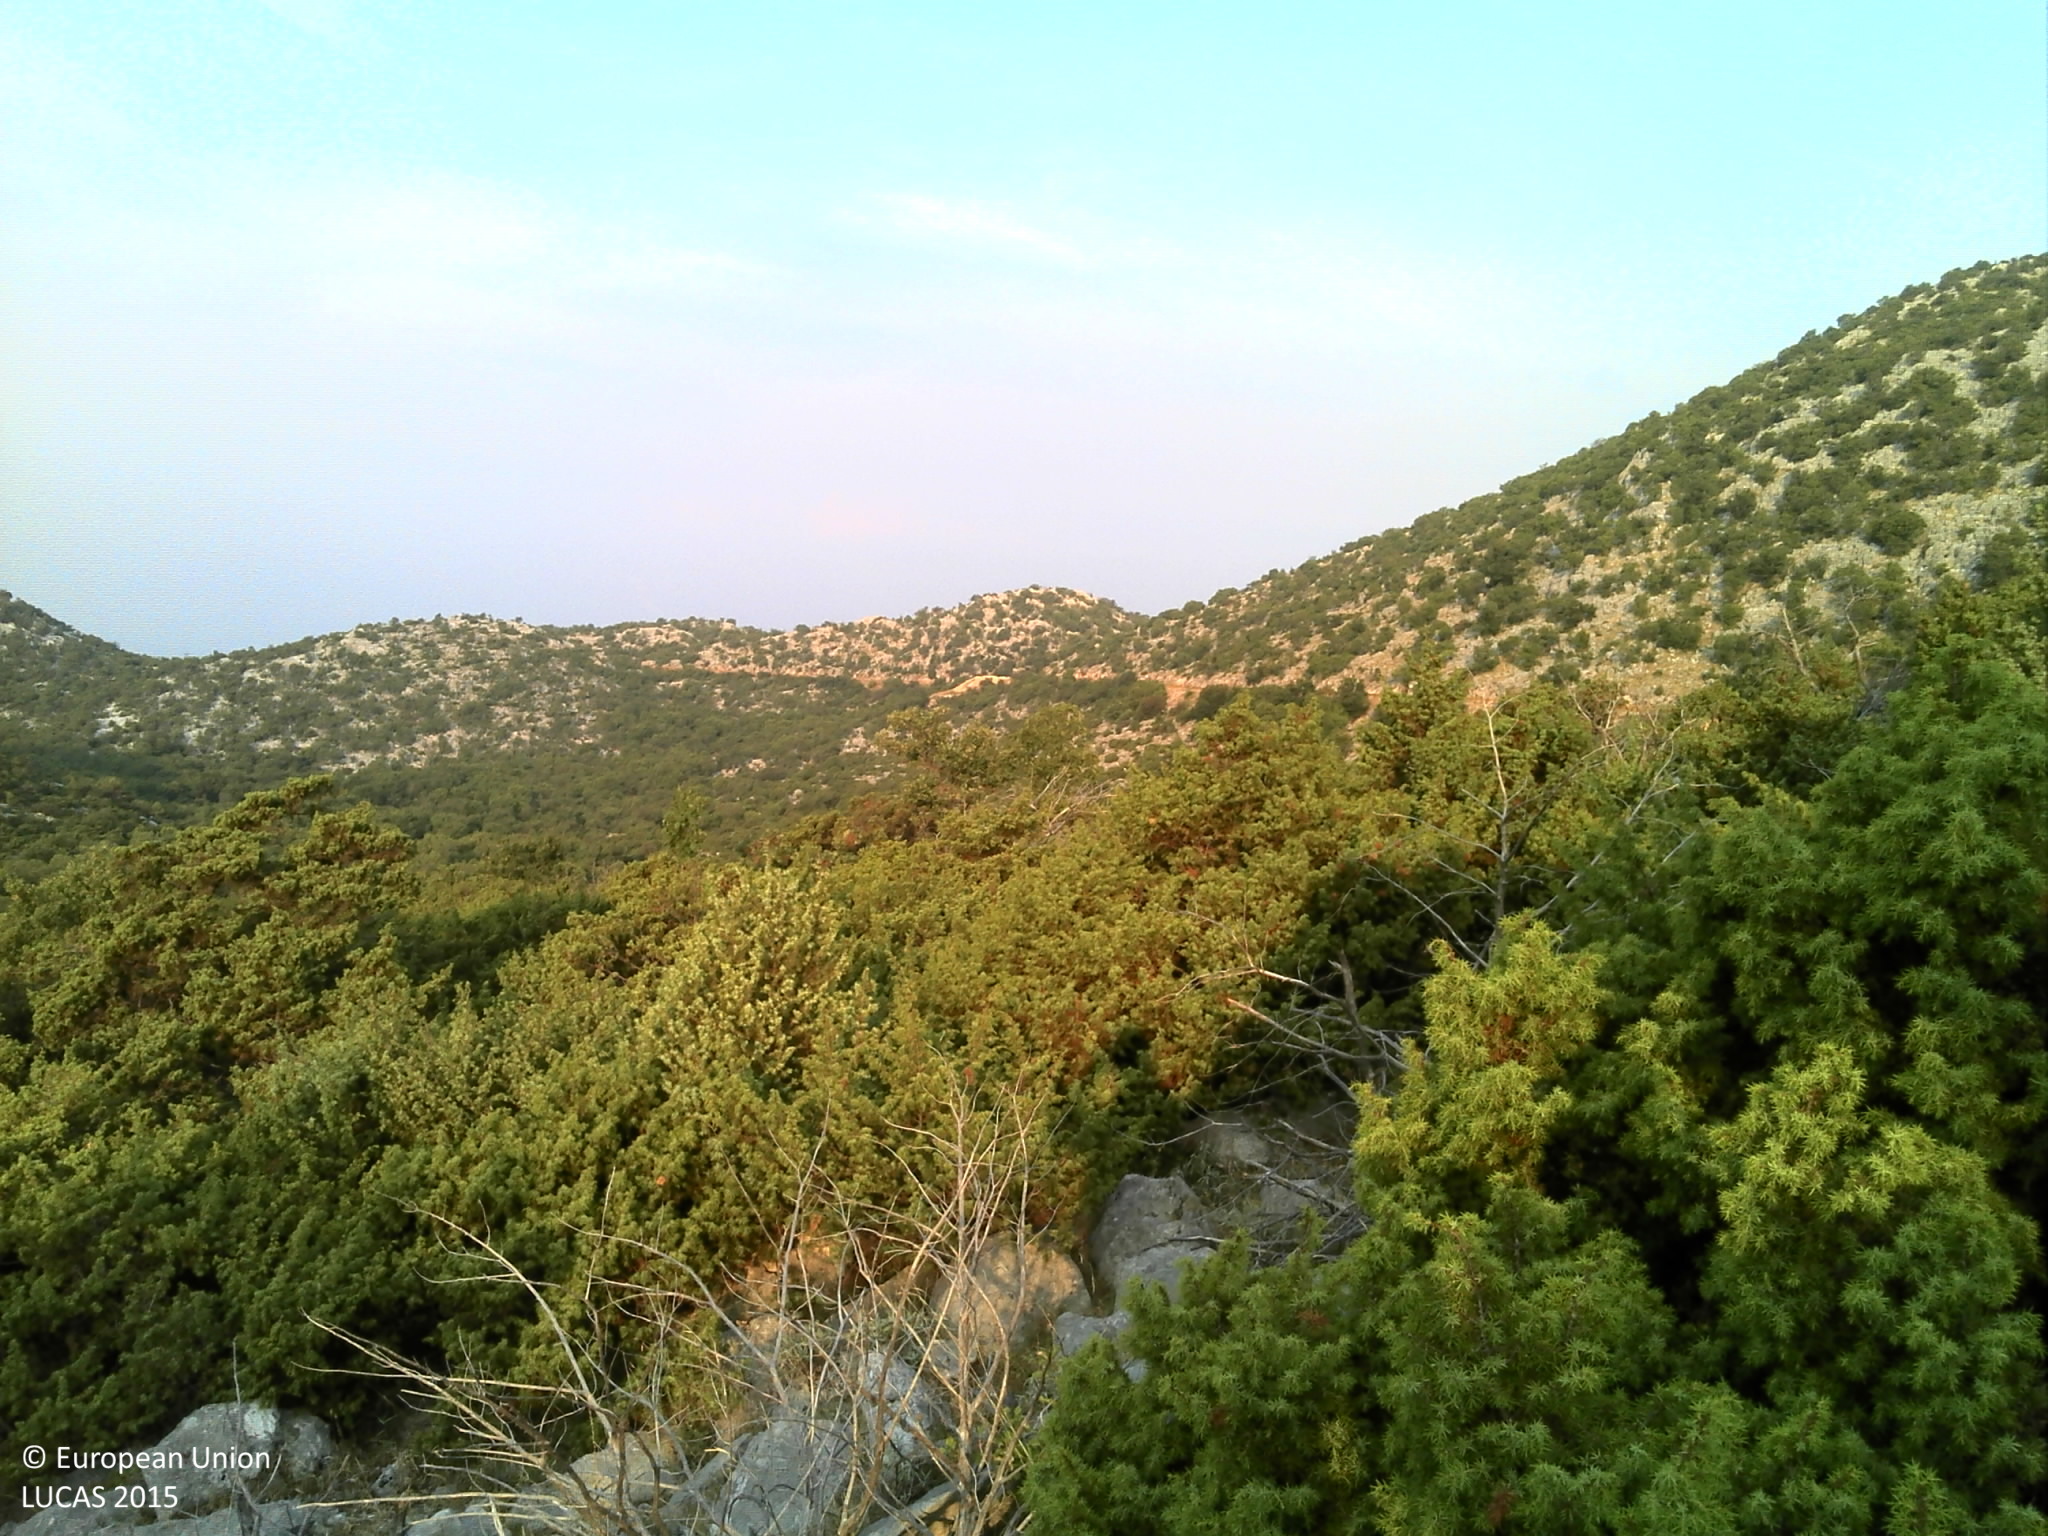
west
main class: Shrubland
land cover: Shrubland with sparse tree cover
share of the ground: 50 - 75 %
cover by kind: shrubs 50 %, unconsolidated bare surface 25 %, herbaceous plants 10 %, consolidated bare surface 10 %, broadleaved forest trees 5 %
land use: Agriculture (excluding fallow land and kitchen gardens)
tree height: < 5 m
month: August
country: HR
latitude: 43.2367
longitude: 17.1206
